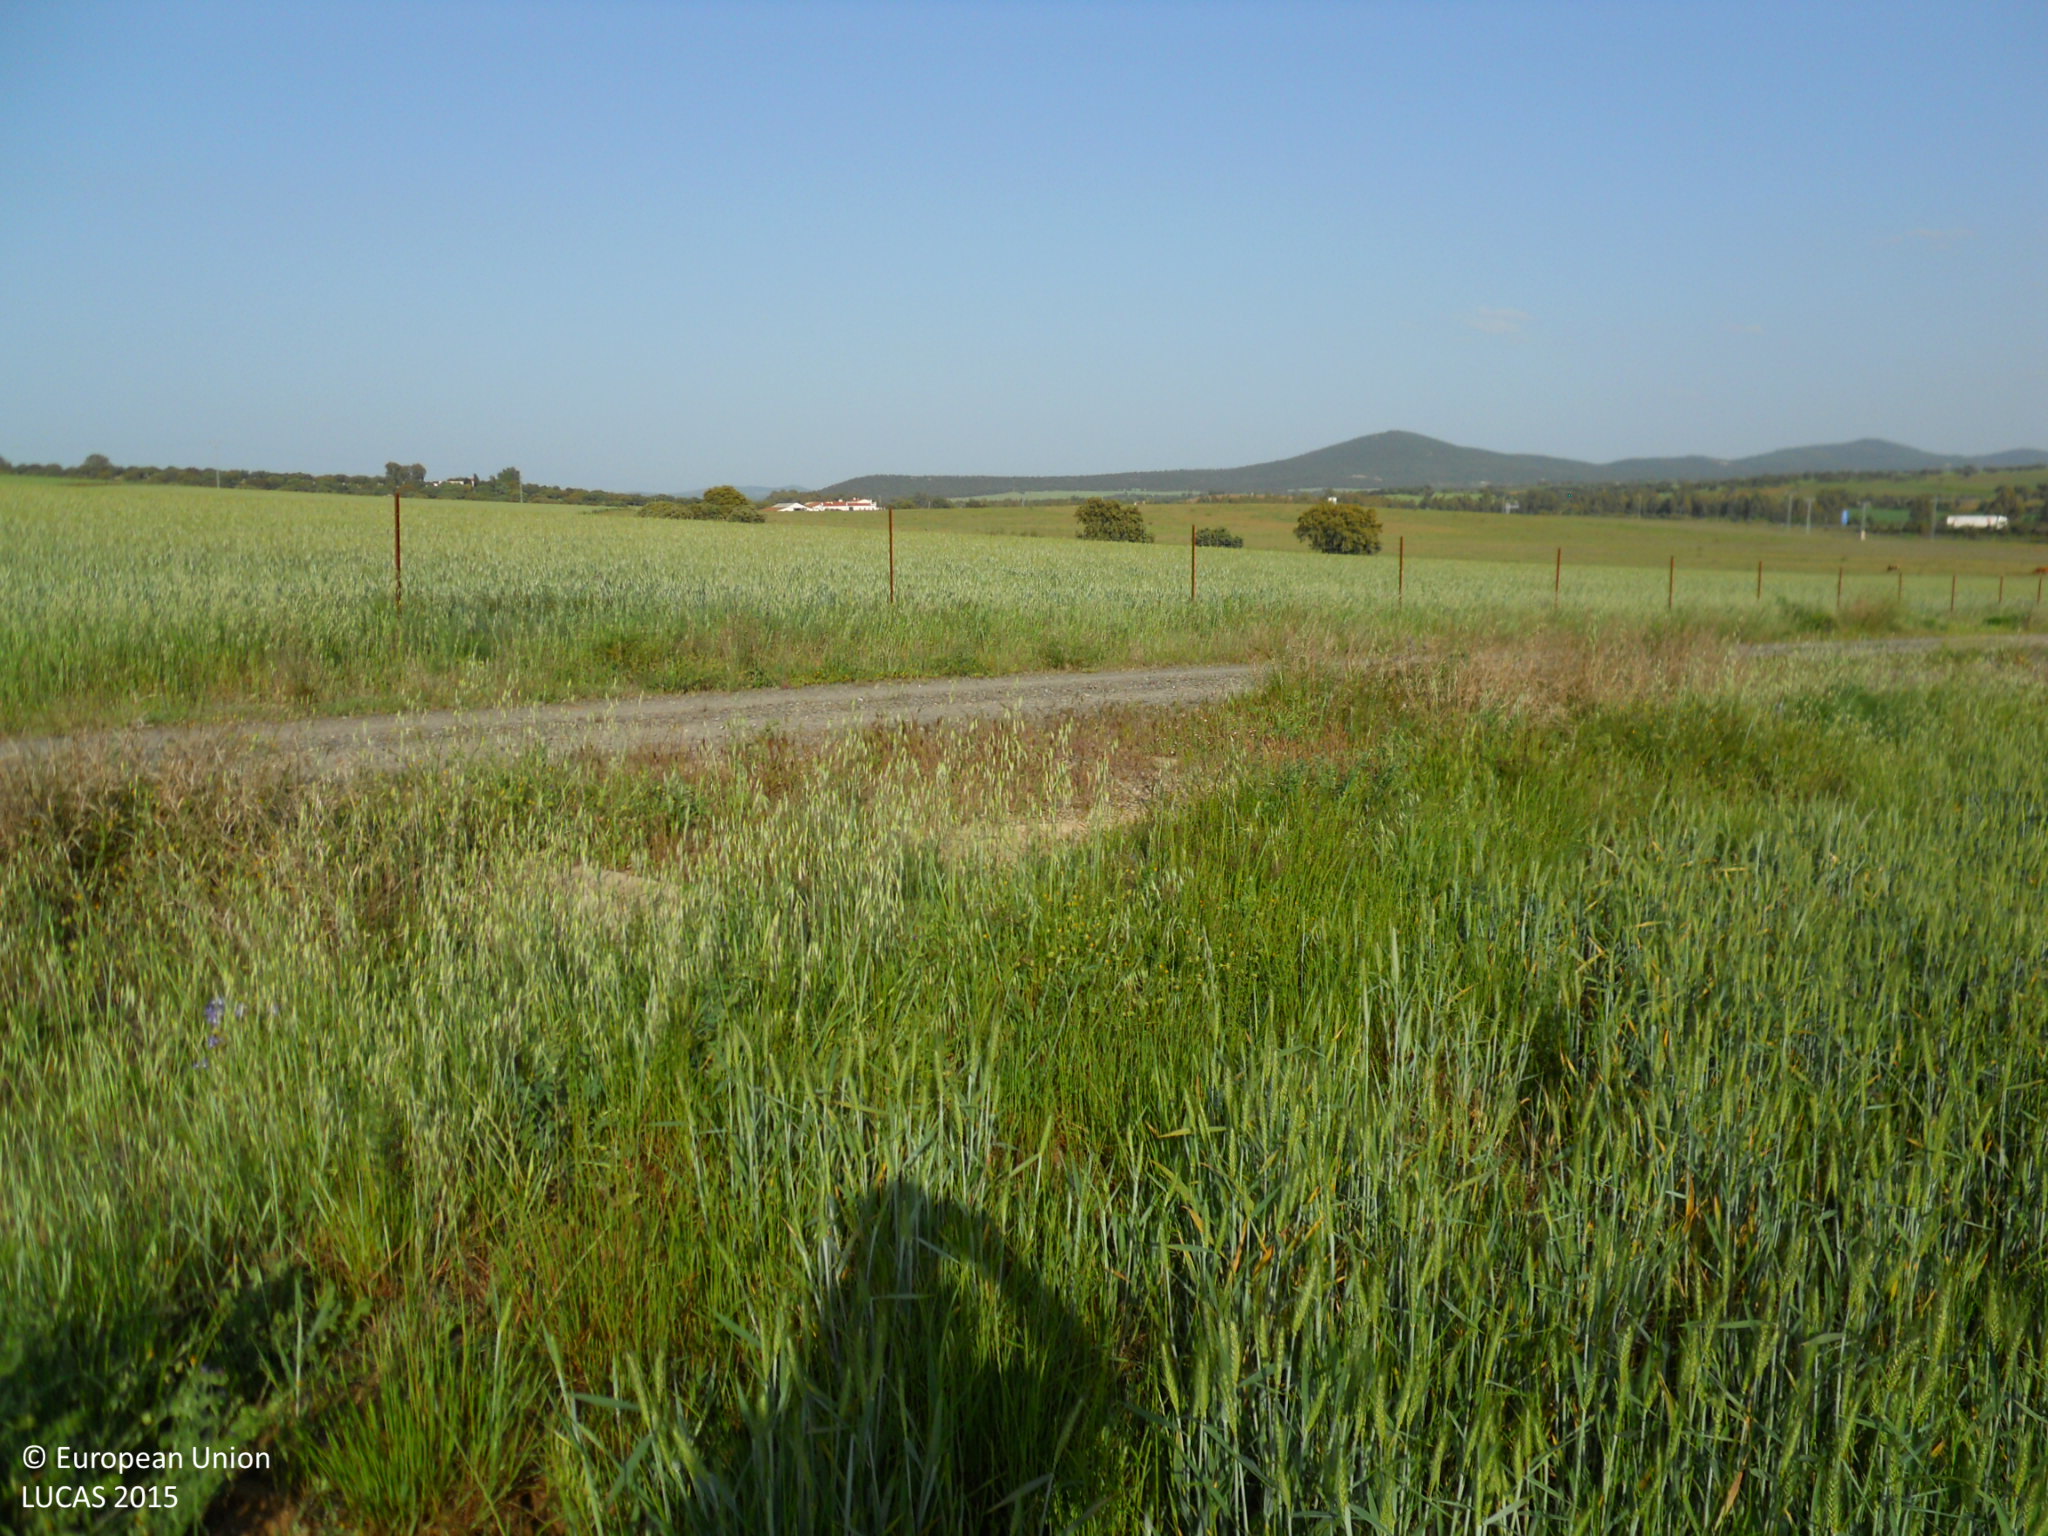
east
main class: Cropland
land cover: Barley
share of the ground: > 75 %
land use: Agriculture (excluding fallow land and kitchen gardens)
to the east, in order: Grass margins; Barley; Tracks; Grass margins; Fences; Grass margins; Barley; Single bushes/trees
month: April
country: ES
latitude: 39.0525
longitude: -6.3414
